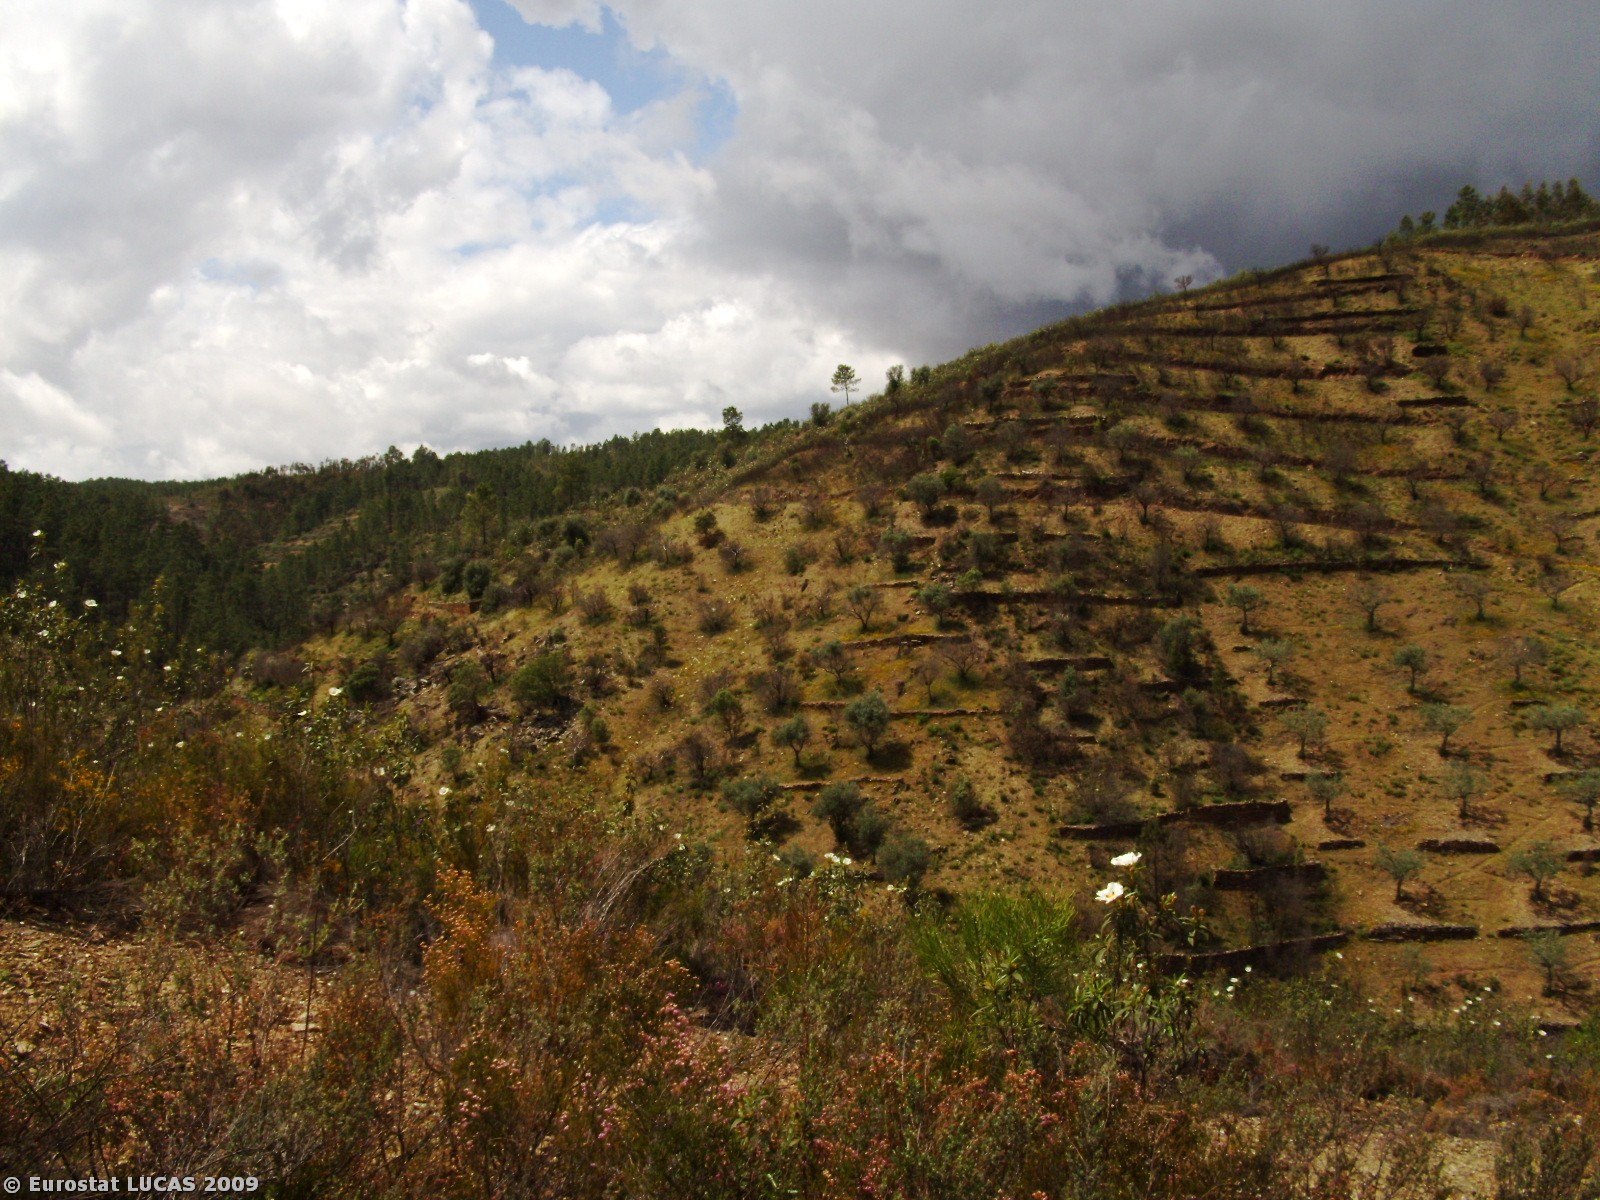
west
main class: Woodland
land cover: Coniferous woodland
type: coniferous forest of the mediterranean region
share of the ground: 50 - 75 %
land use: Forestry
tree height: > 5 m
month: April
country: PT
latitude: 39.8226
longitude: -7.6150
